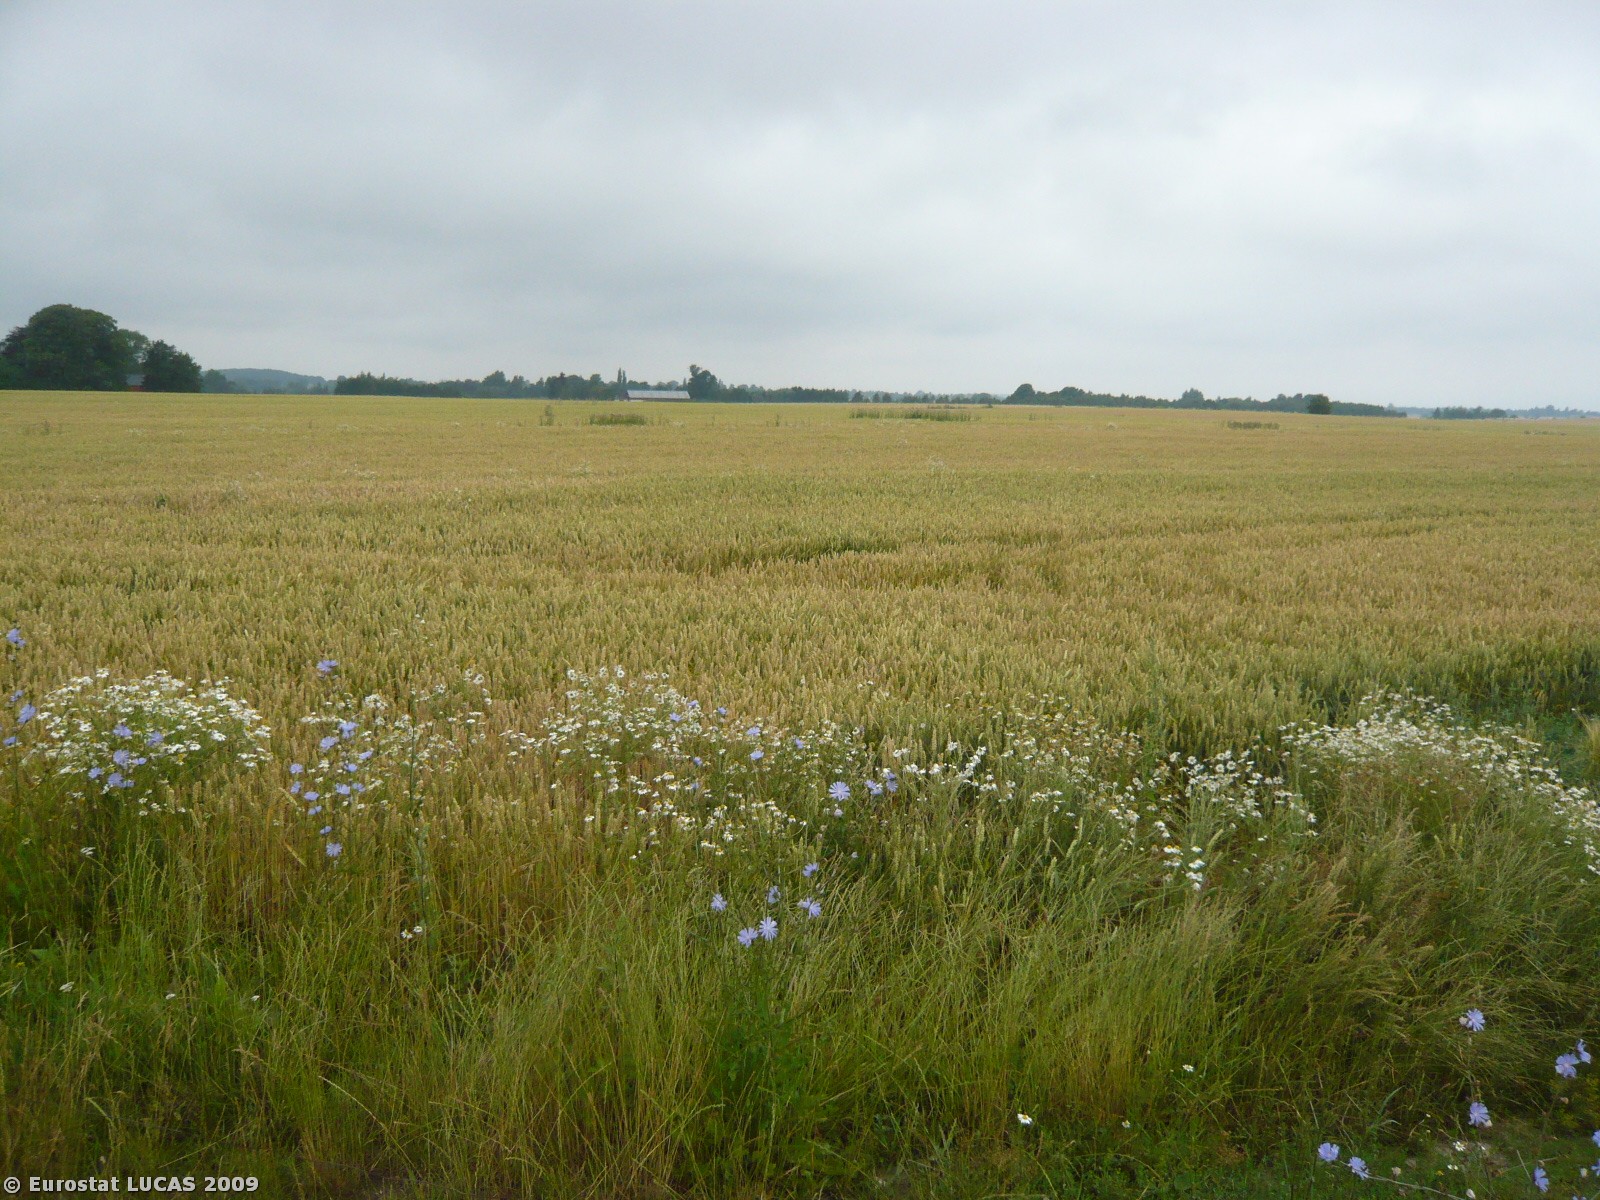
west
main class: Cropland
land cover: Common wheat
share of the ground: > 75 %
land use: Agriculture (excluding fallow land and kitchen gardens)
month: July
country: DK
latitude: 55.6884
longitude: 11.8912
